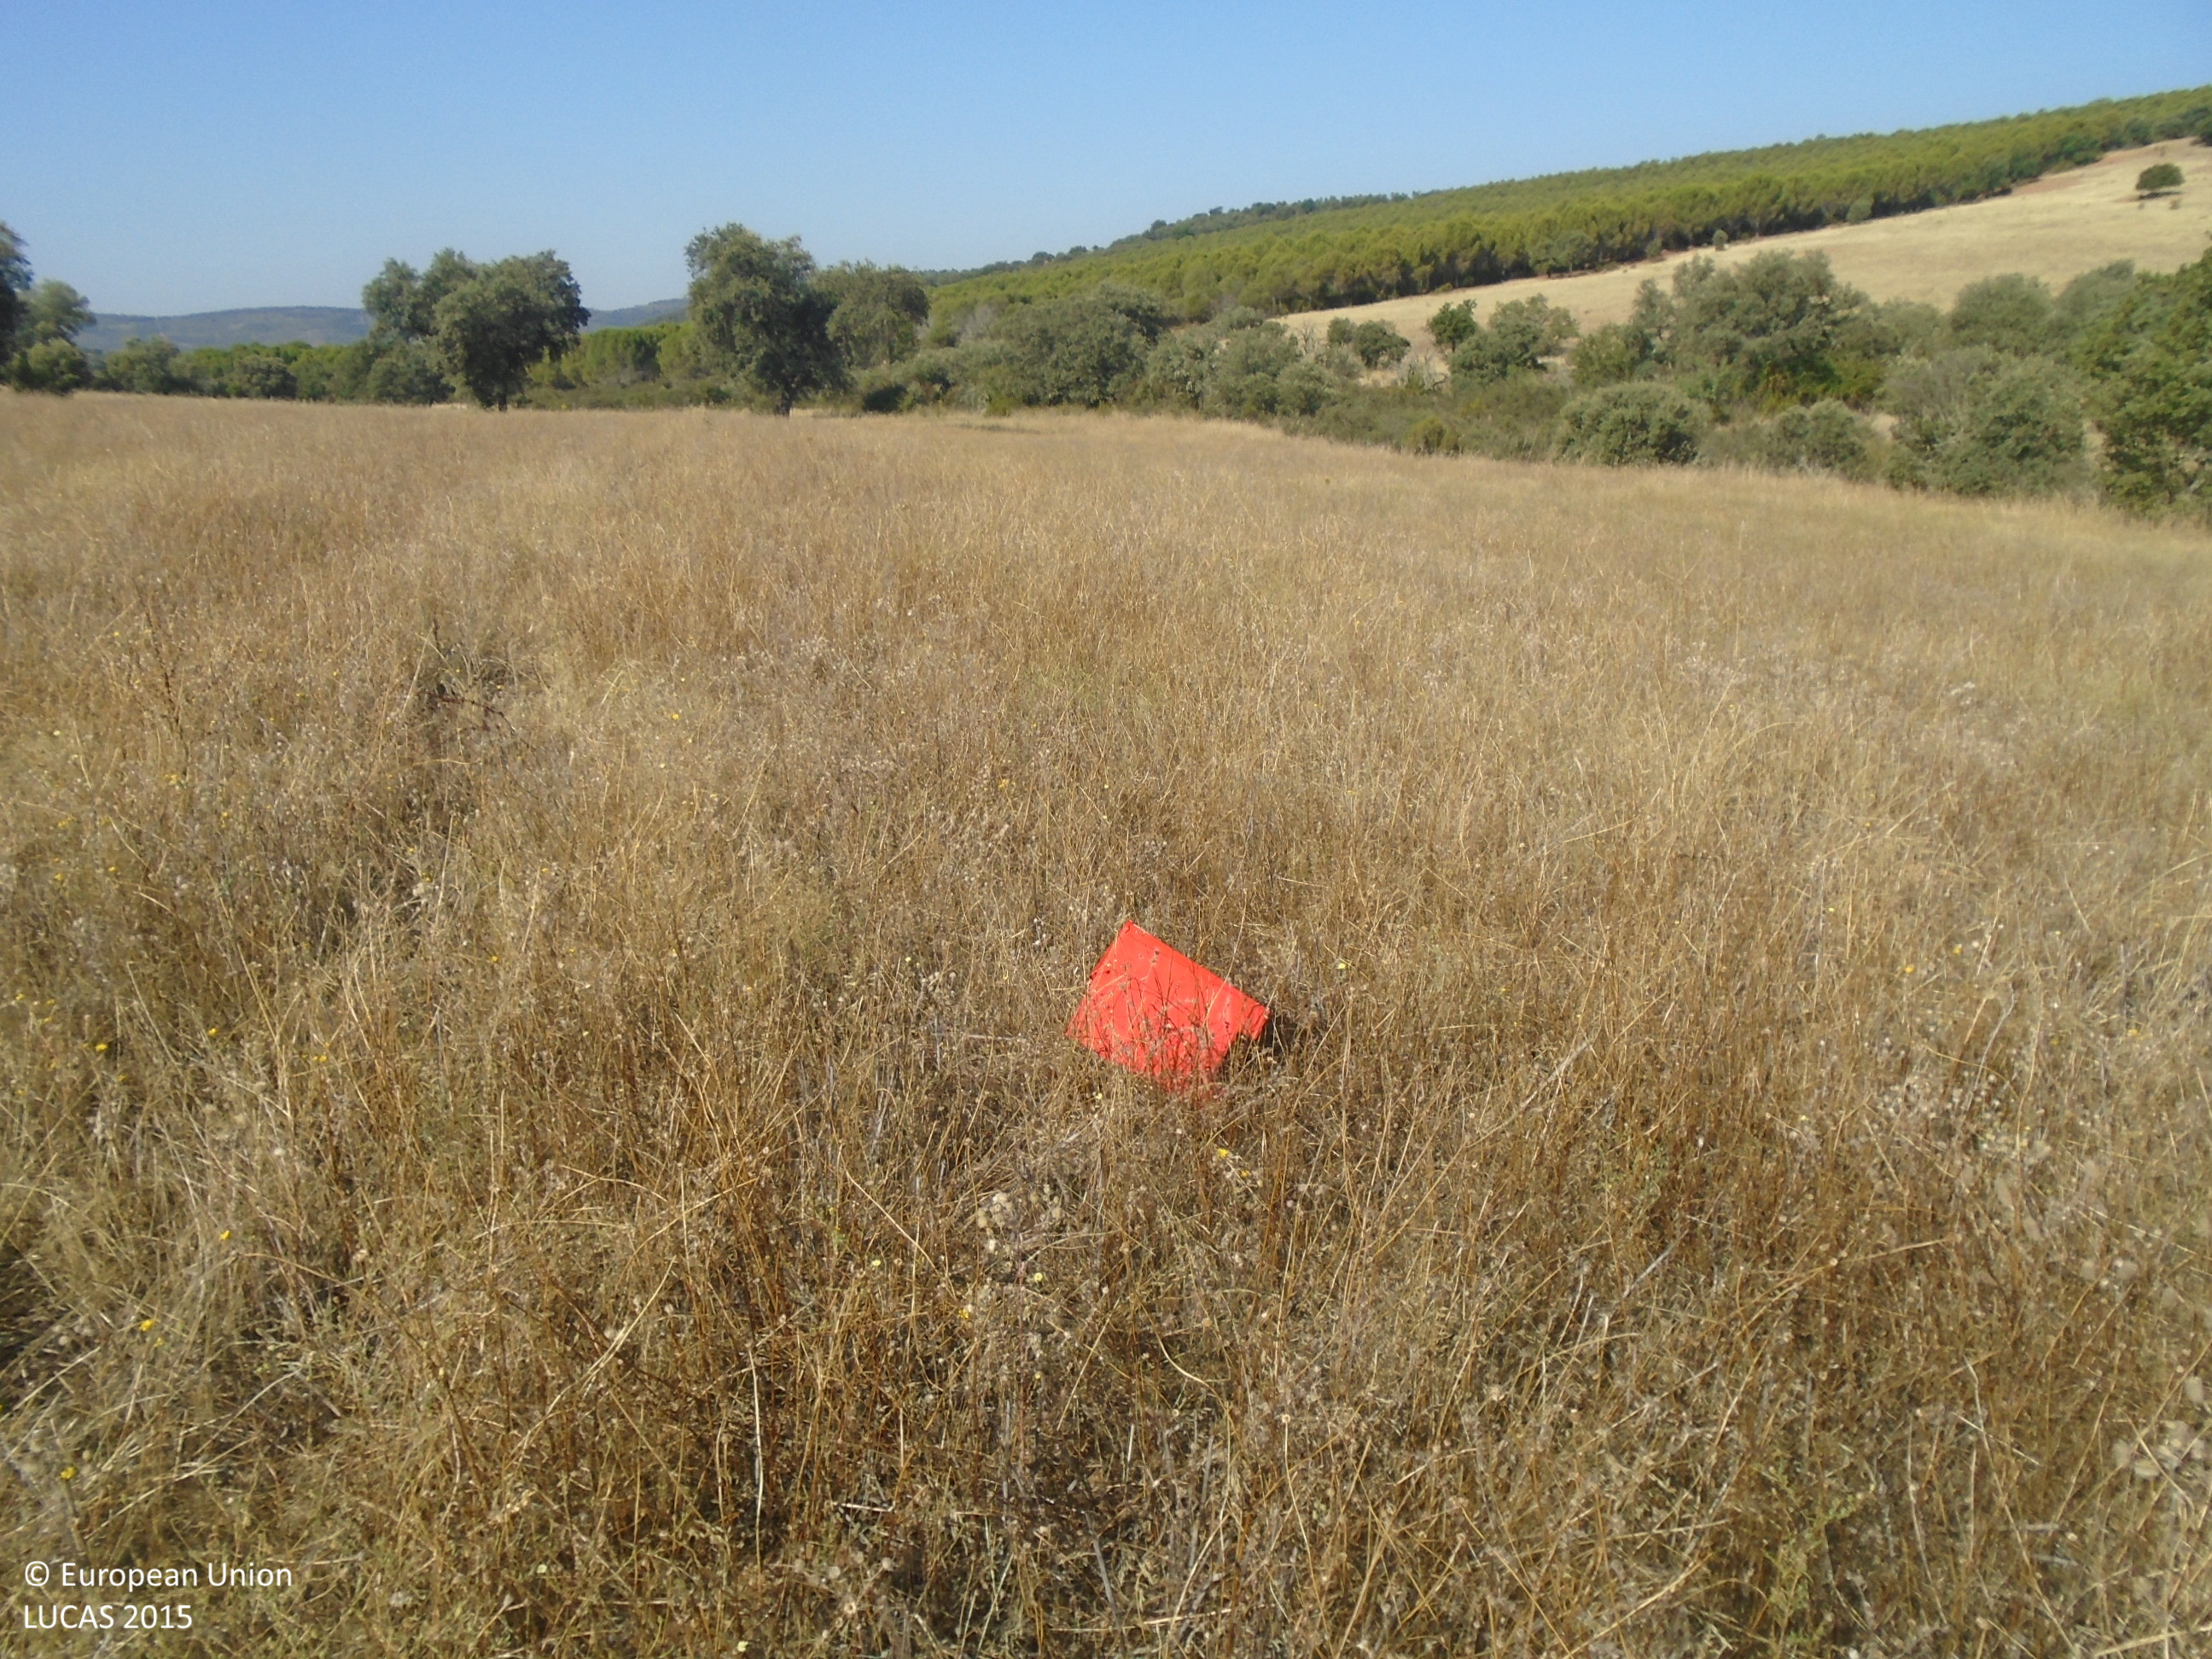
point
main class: Grassland
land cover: Grassland without tree/shrub cover
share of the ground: > 75 %
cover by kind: herbaceous plants 100 %
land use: Agriculture (excluding fallow land and kitchen gardens)
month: July
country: ES
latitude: 39.4204
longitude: -4.8736
